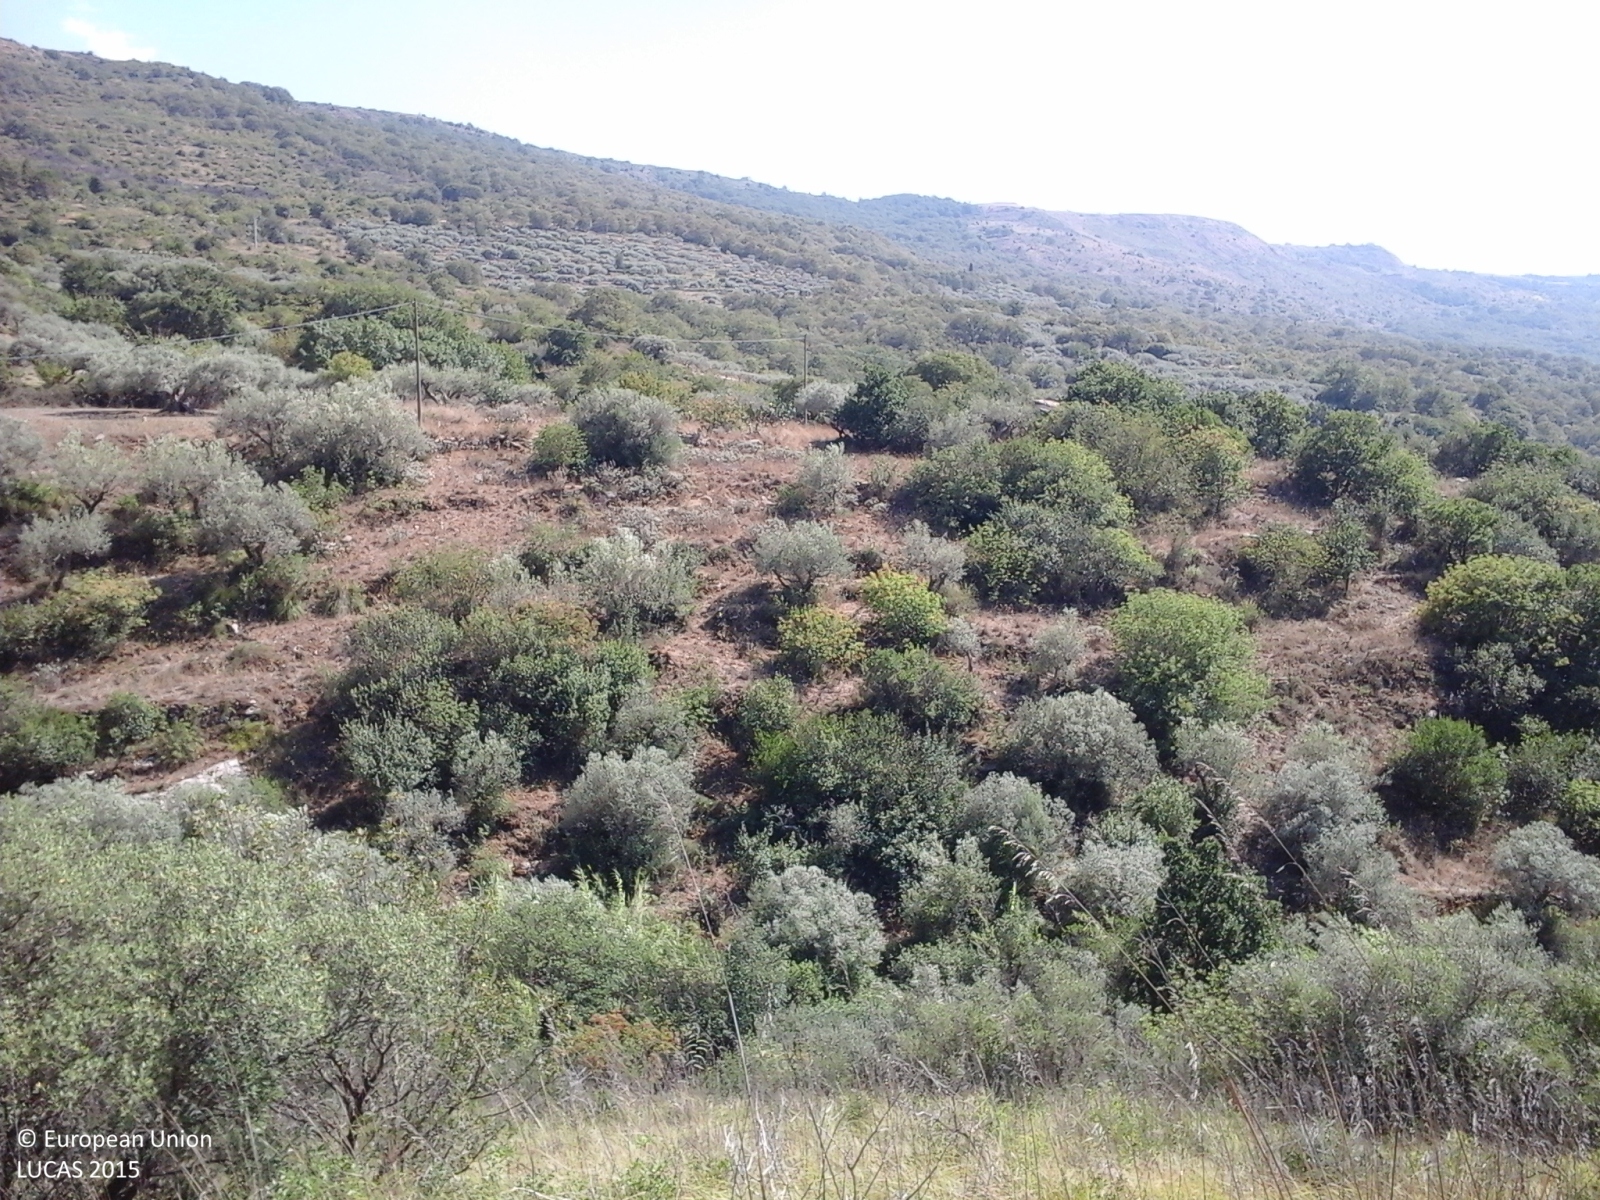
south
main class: Shrubland
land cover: Shrubland with sparse tree cover
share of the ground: > 75 %
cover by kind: shrubs 90 %, coniferous forest trees 5 %, herbaceous plants 5 %
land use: Semi-natural and natural areas not in use
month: July
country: IT
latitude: 37.1492
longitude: 14.8829
